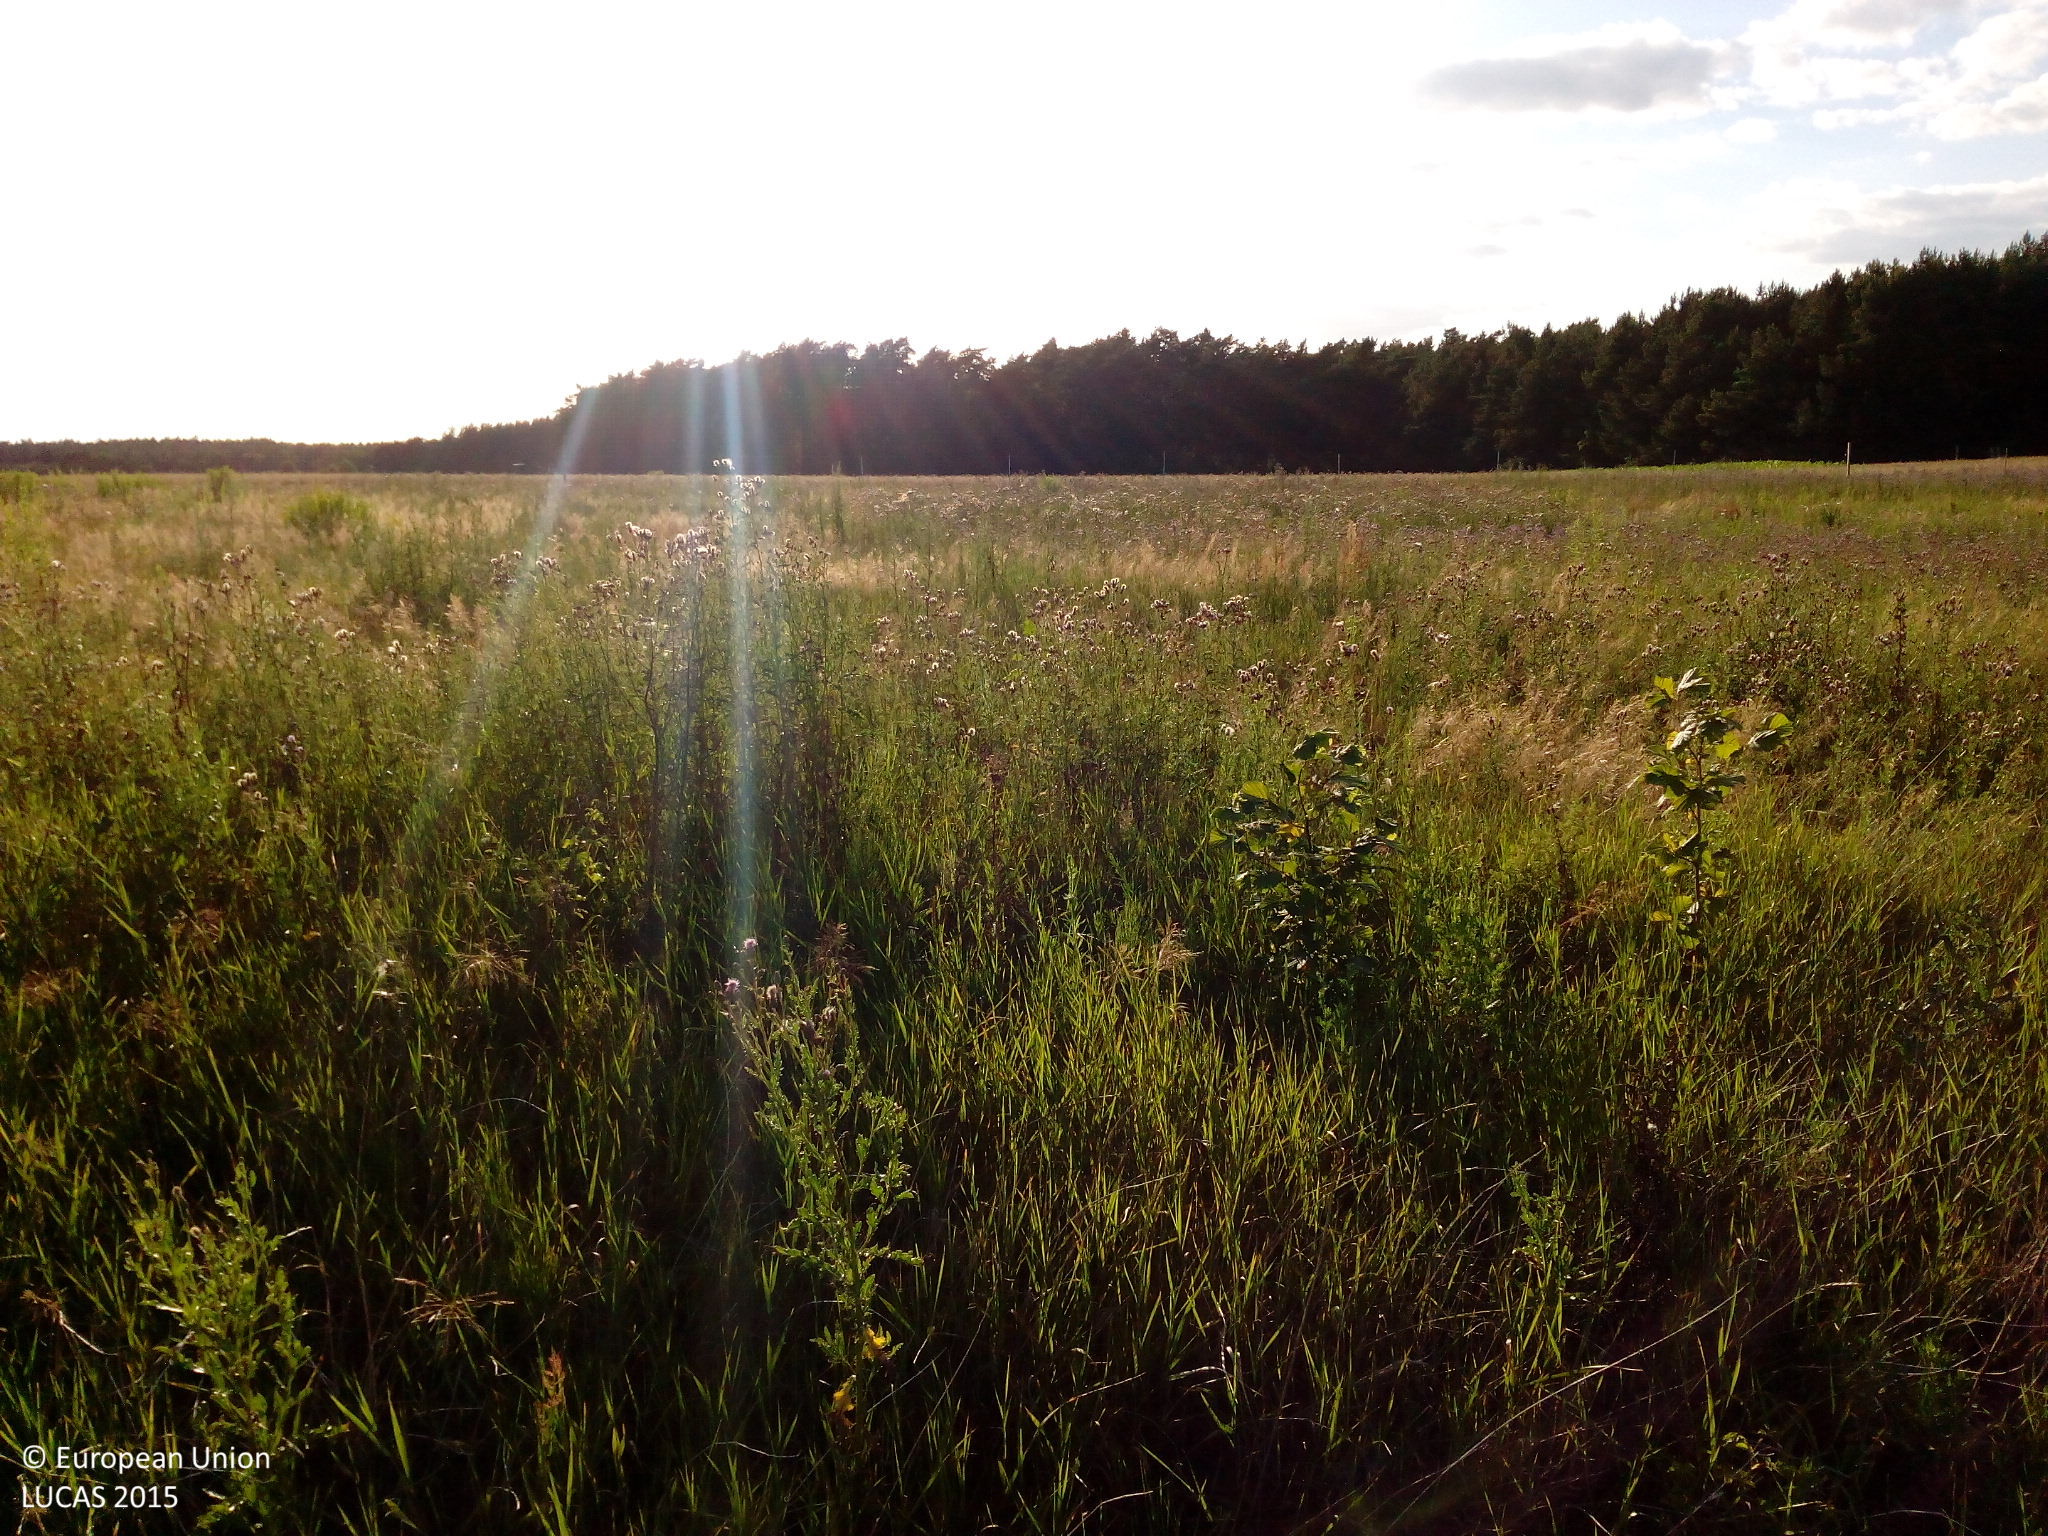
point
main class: Grassland
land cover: Grassland without tree/shrub cover
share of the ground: > 75 %
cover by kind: herbaceous plants 100 %
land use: Forestry
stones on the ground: < 10 %
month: July
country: DE
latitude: 52.7359
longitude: 13.6288
